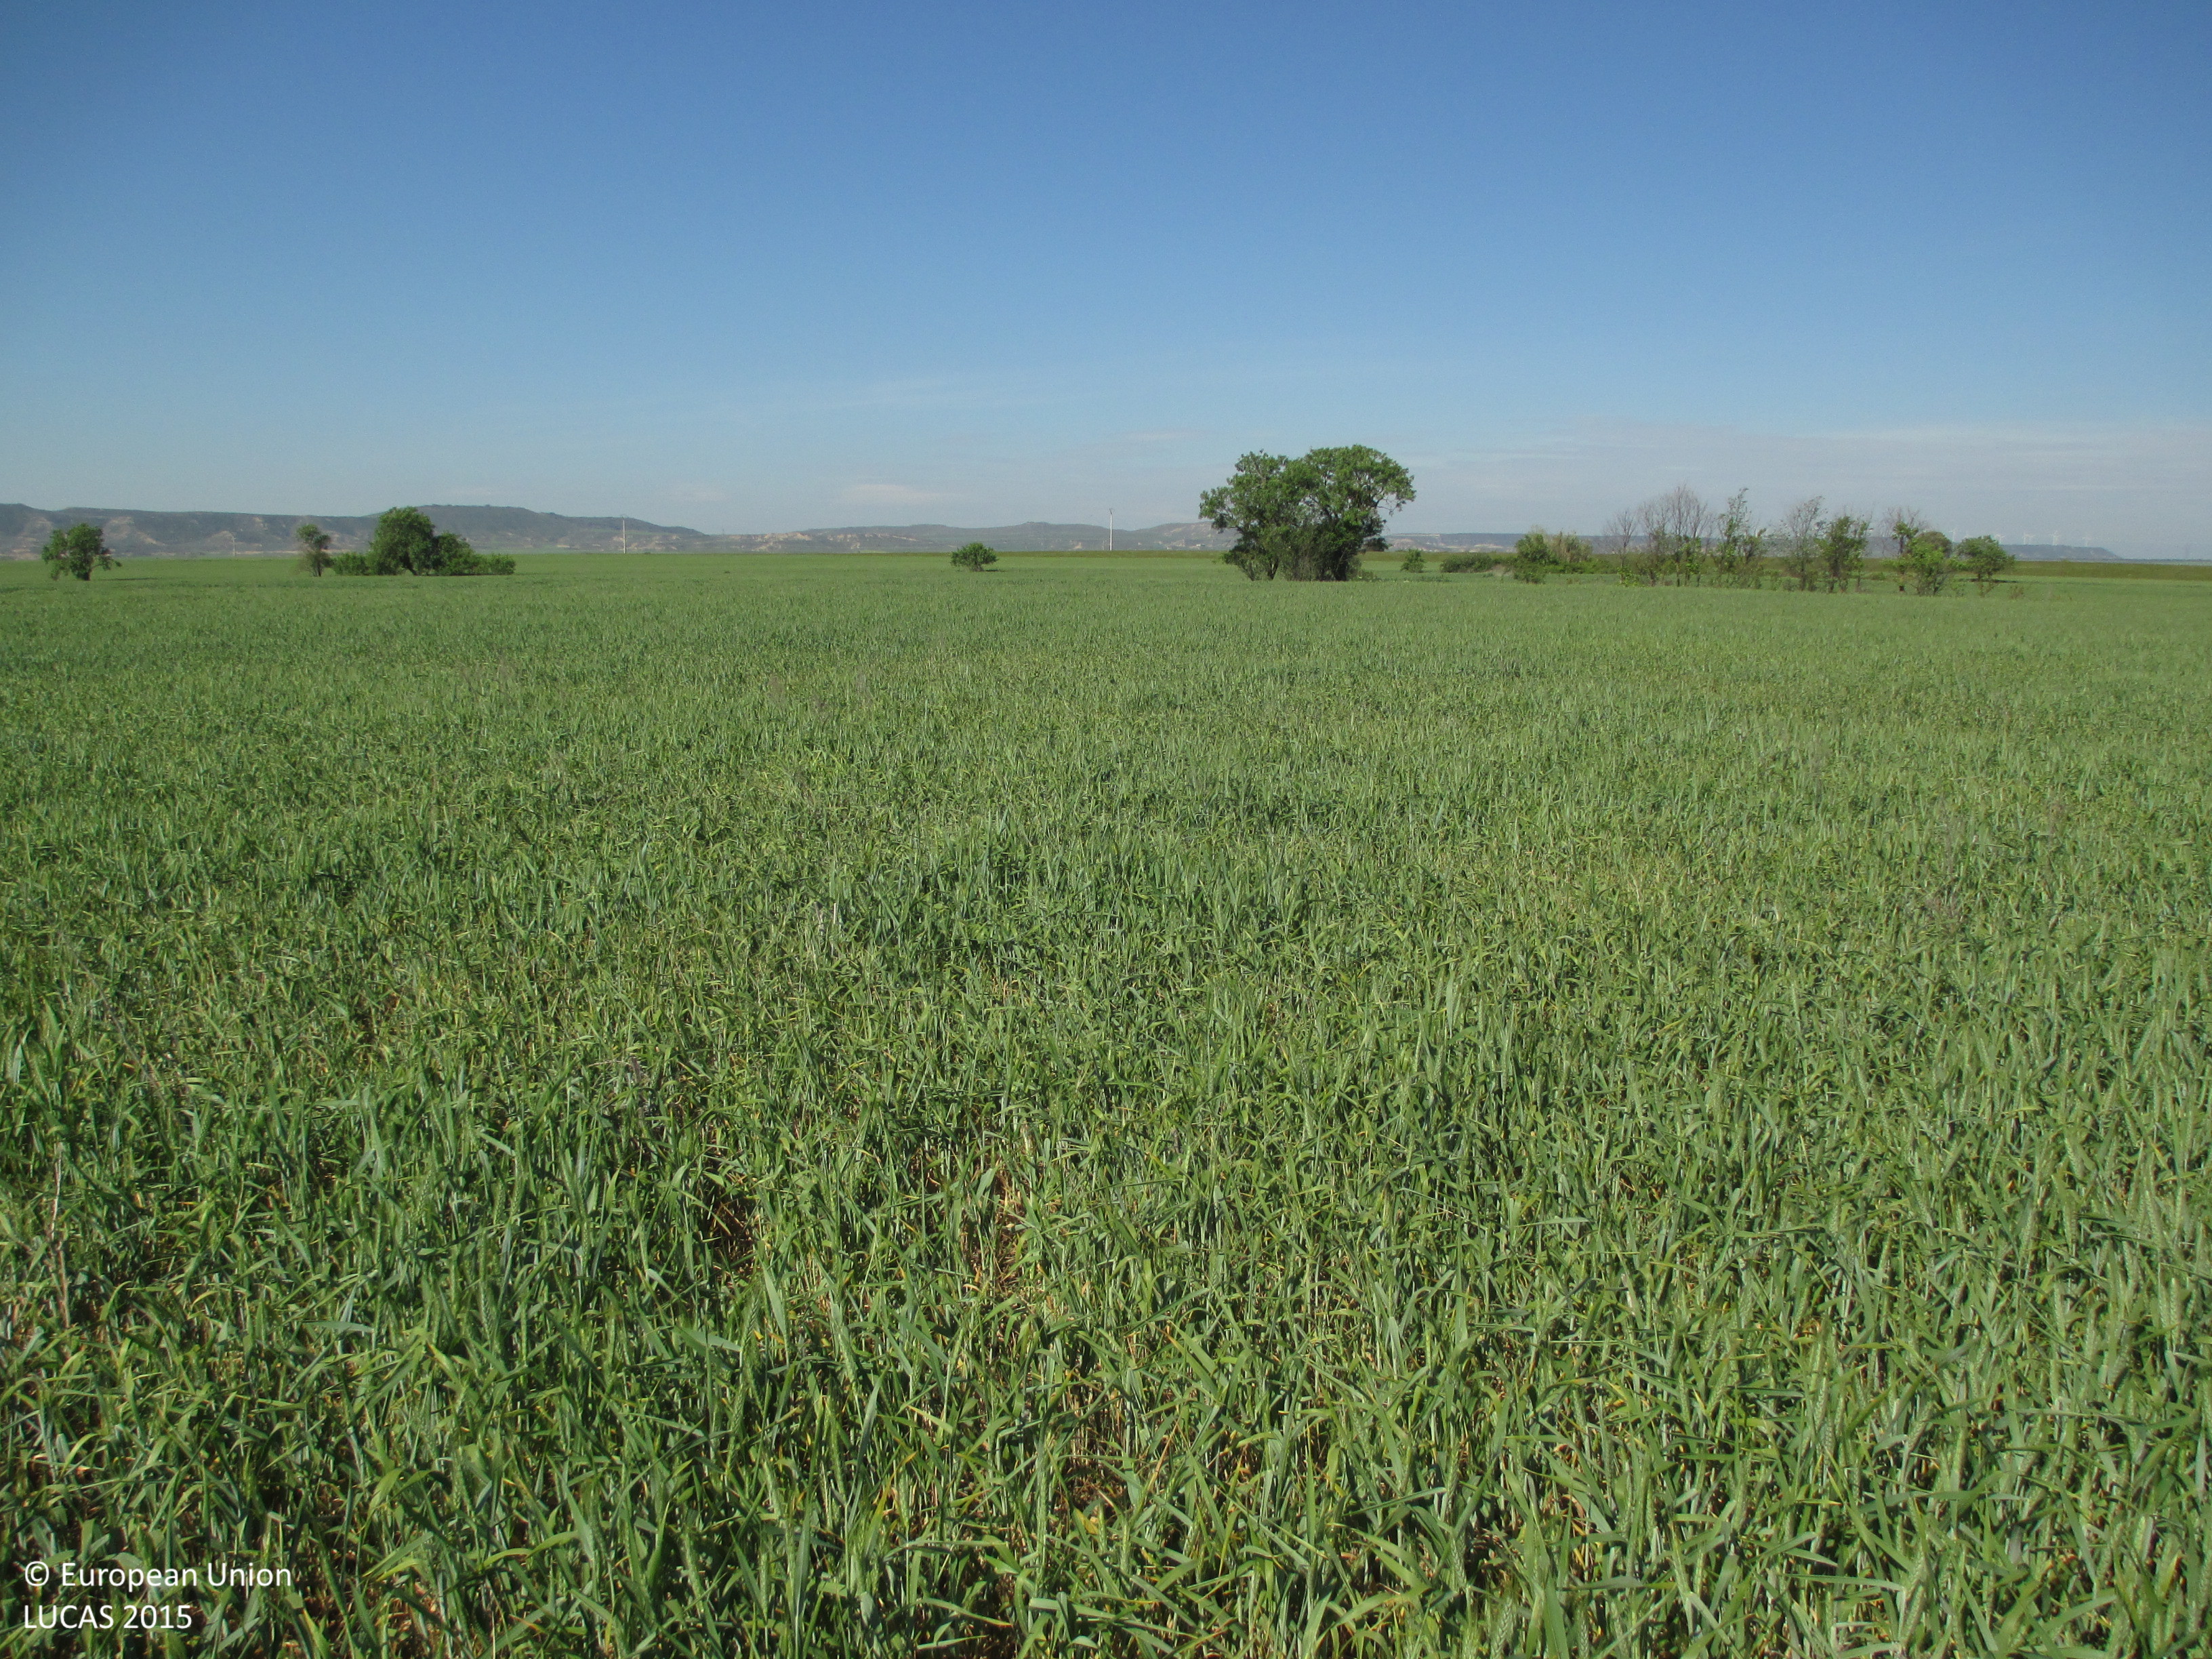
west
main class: Cropland
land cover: Durum wheat
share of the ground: > 75 %
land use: Agriculture (excluding fallow land and kitchen gardens)
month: April
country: ES
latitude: 42.1289
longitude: -0.4628
